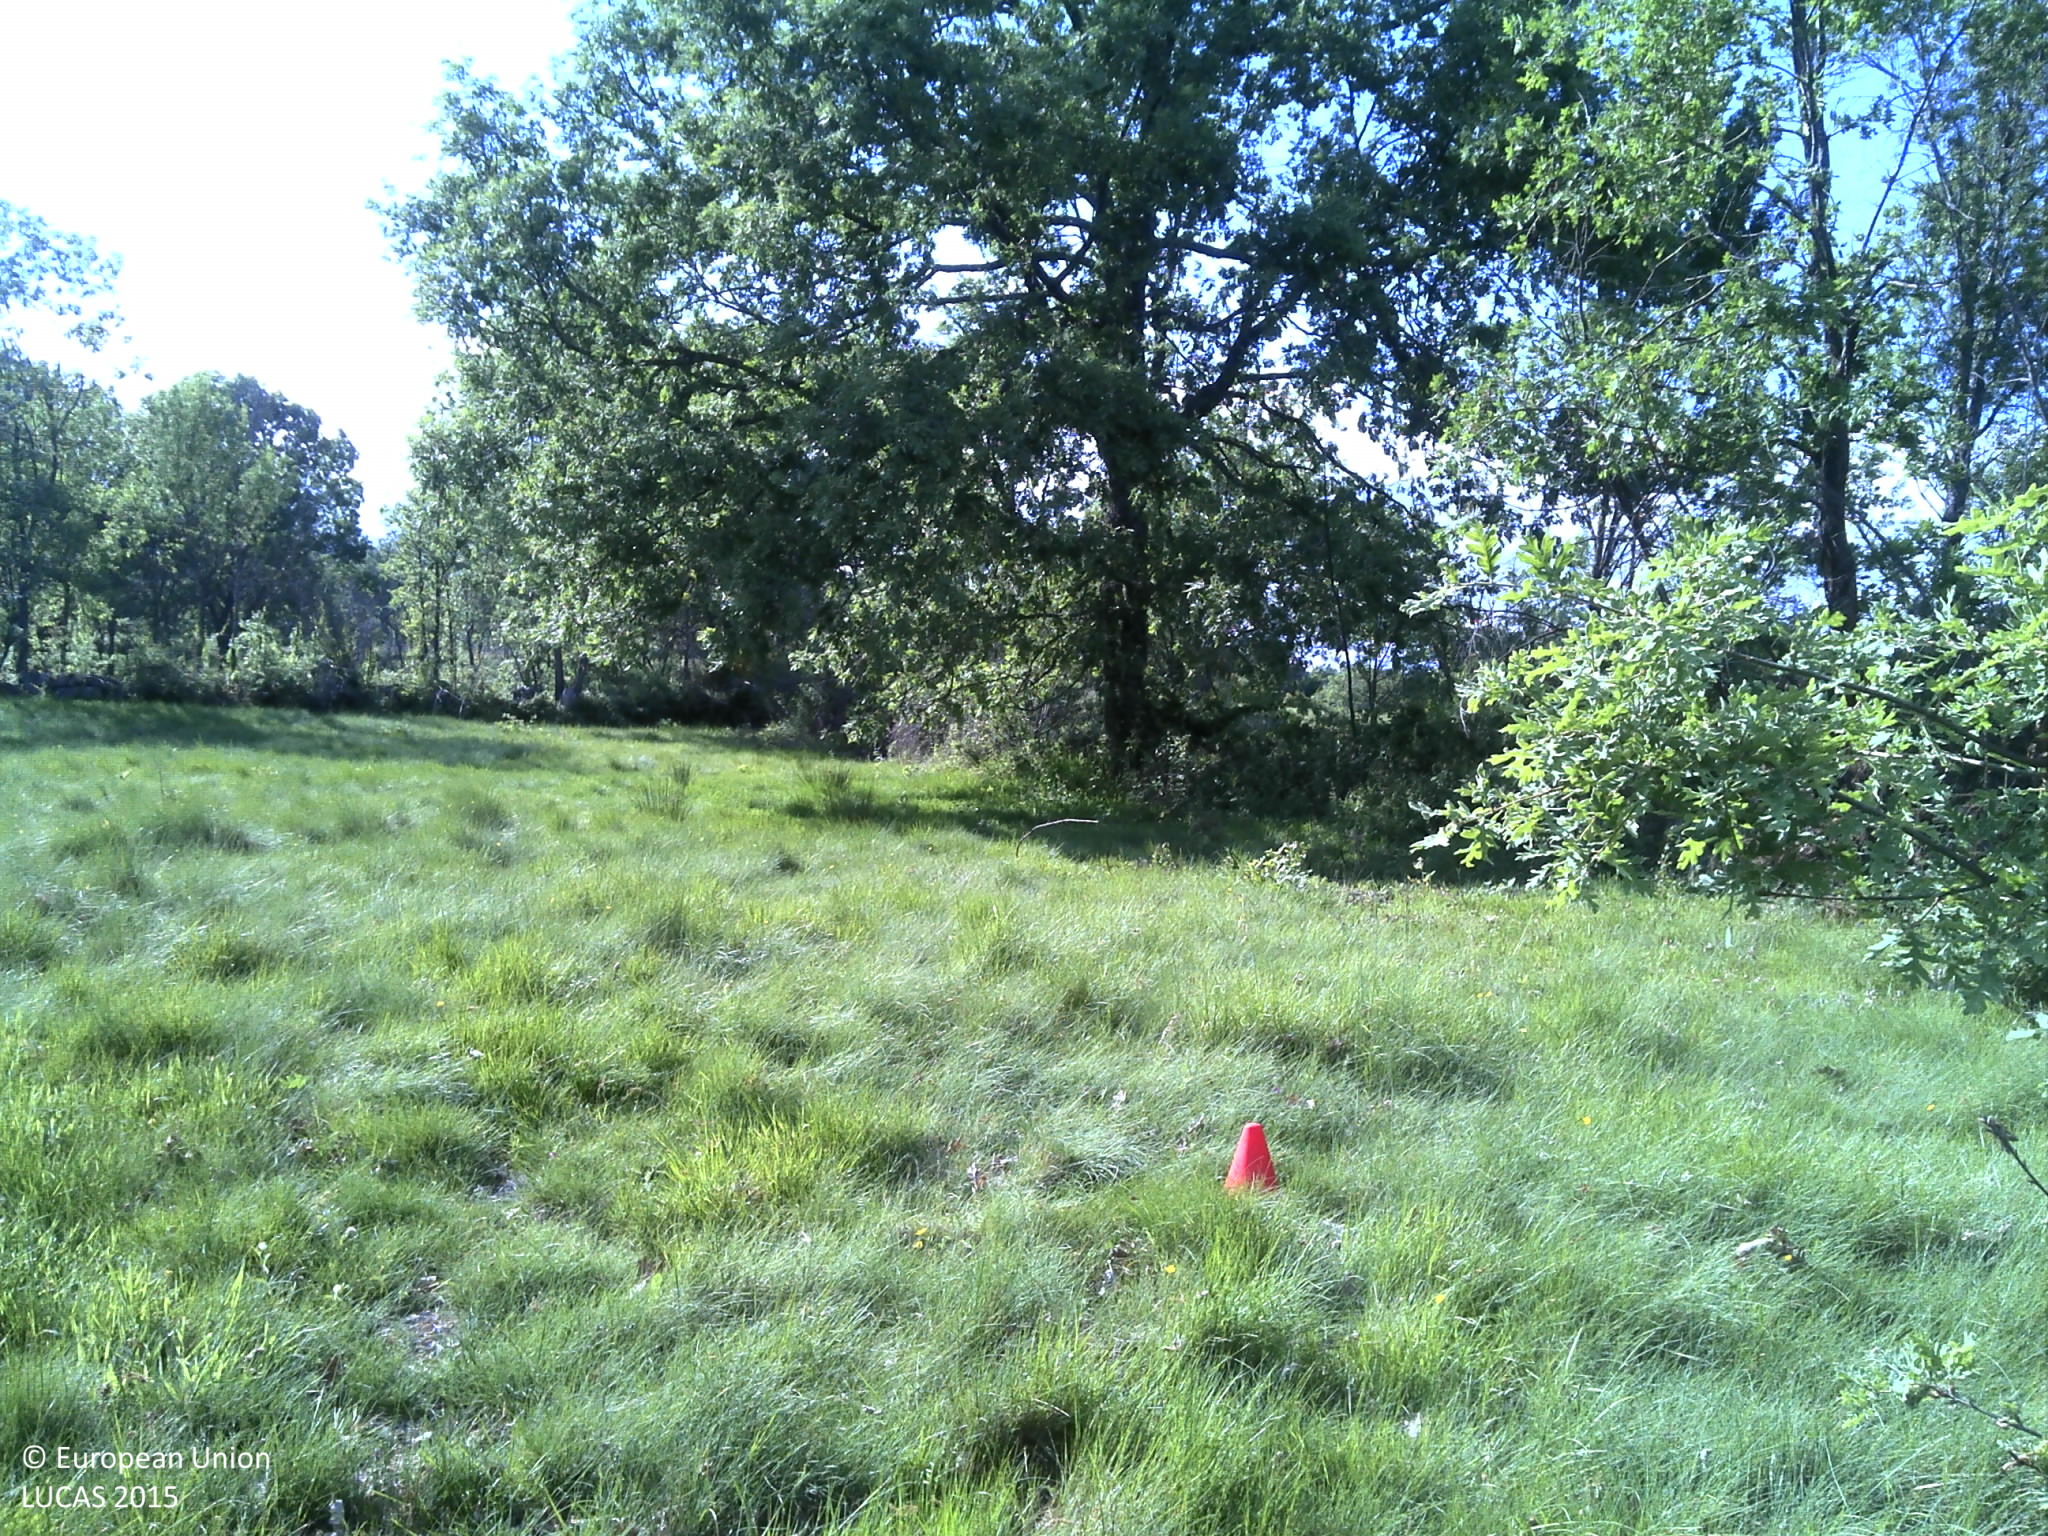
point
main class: Grassland
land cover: Grassland with sparse tree/shrub cover
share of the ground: > 75 %
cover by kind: herbaceous plants 95 %, broadleaved forest trees 5 %
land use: Agriculture (excluding fallow land and kitchen gardens)
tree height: > 5 m
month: May
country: PT
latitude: 41.6794
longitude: -7.3400
